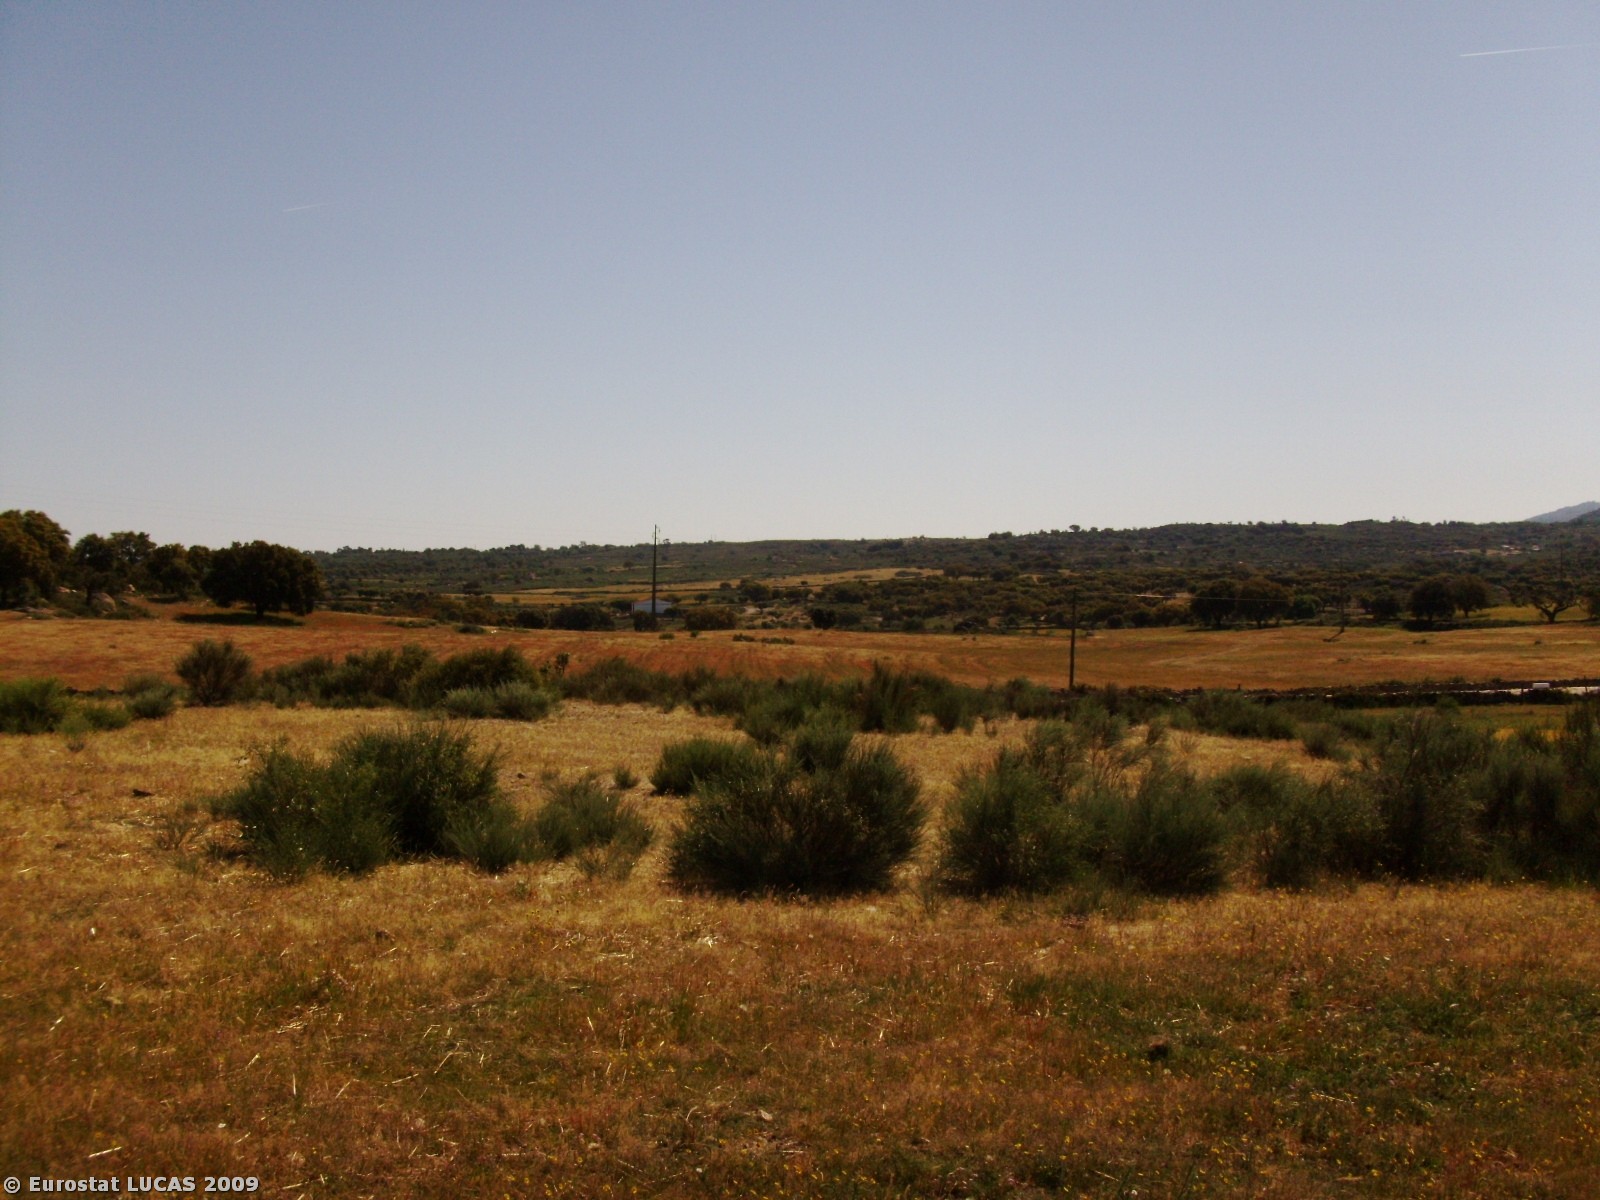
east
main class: Grassland
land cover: Grassland with sparse tree/shrub cover
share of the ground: > 75 %
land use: Agriculture (excluding fallow land and kitchen gardens)
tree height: > 5 m
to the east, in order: Grassland with sparse tree/shrub cover; Fences; Dry stone walls; Paved roads, cycling and walking lanes; Dry stone walls; Electric lines; Grassland without tree/shrub cover
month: May
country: PT
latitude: 39.4360
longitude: -7.5082
